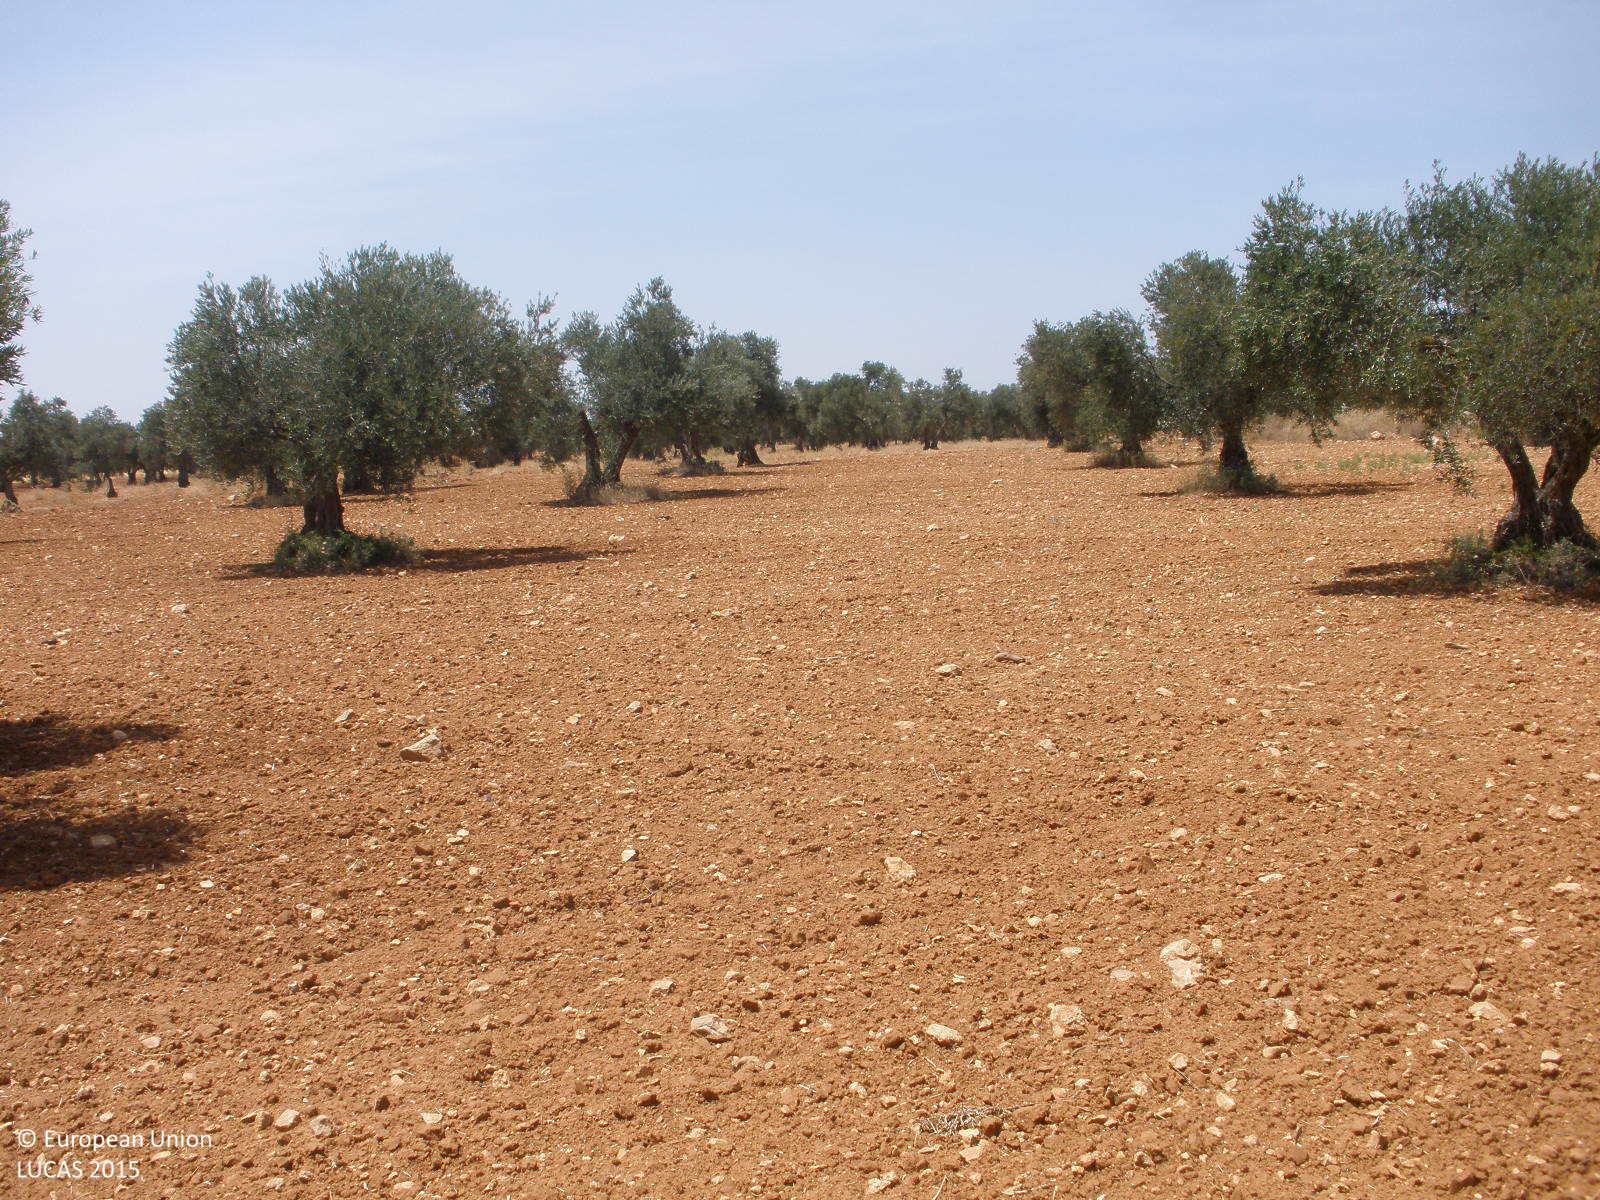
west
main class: Cropland
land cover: Olive groves
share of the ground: 25 - 50 %
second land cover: Other bare soil
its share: > 75 %
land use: Agriculture (excluding fallow land and kitchen gardens)
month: July
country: ES
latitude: 40.2285
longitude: -3.4889
